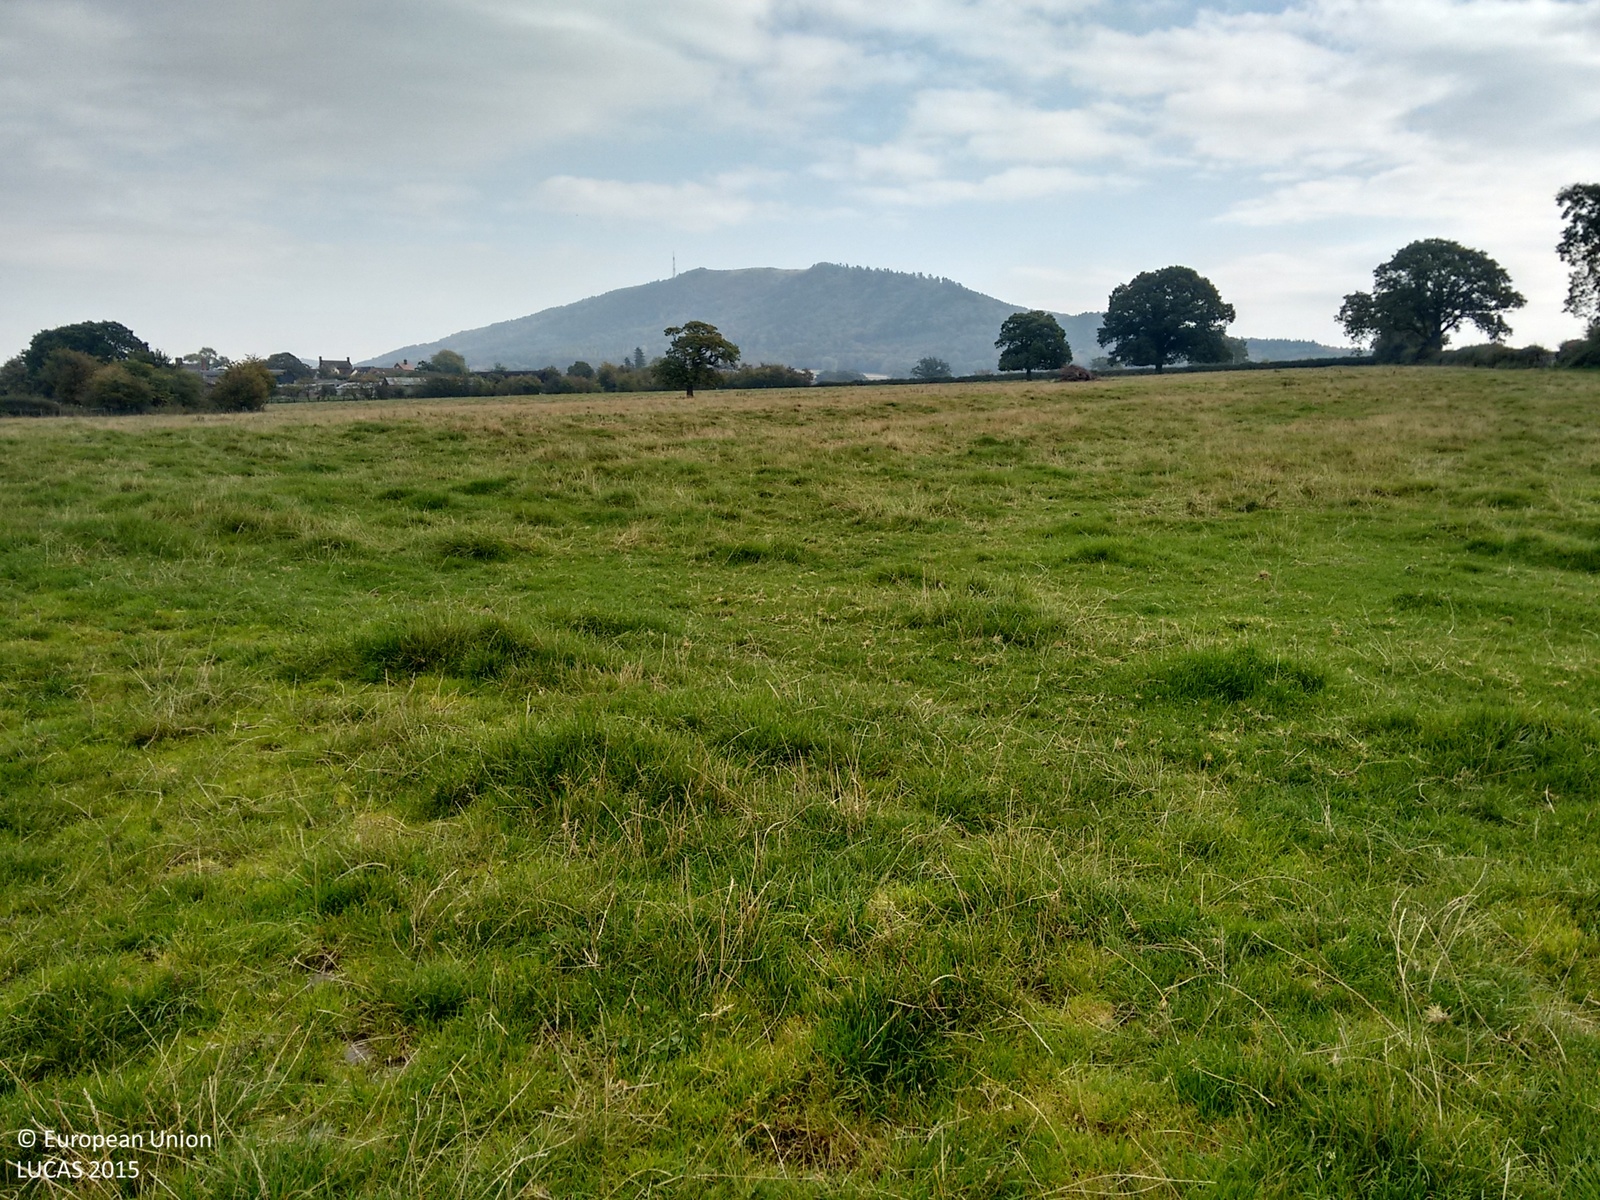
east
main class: Grassland
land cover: Grassland without tree/shrub cover
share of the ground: > 75 %
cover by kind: herbaceous plants 100 %
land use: Agriculture (excluding fallow land and kitchen gardens)
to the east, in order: Grassland without tree/shrub cover
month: October
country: GB
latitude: 52.6684
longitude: -2.5927
